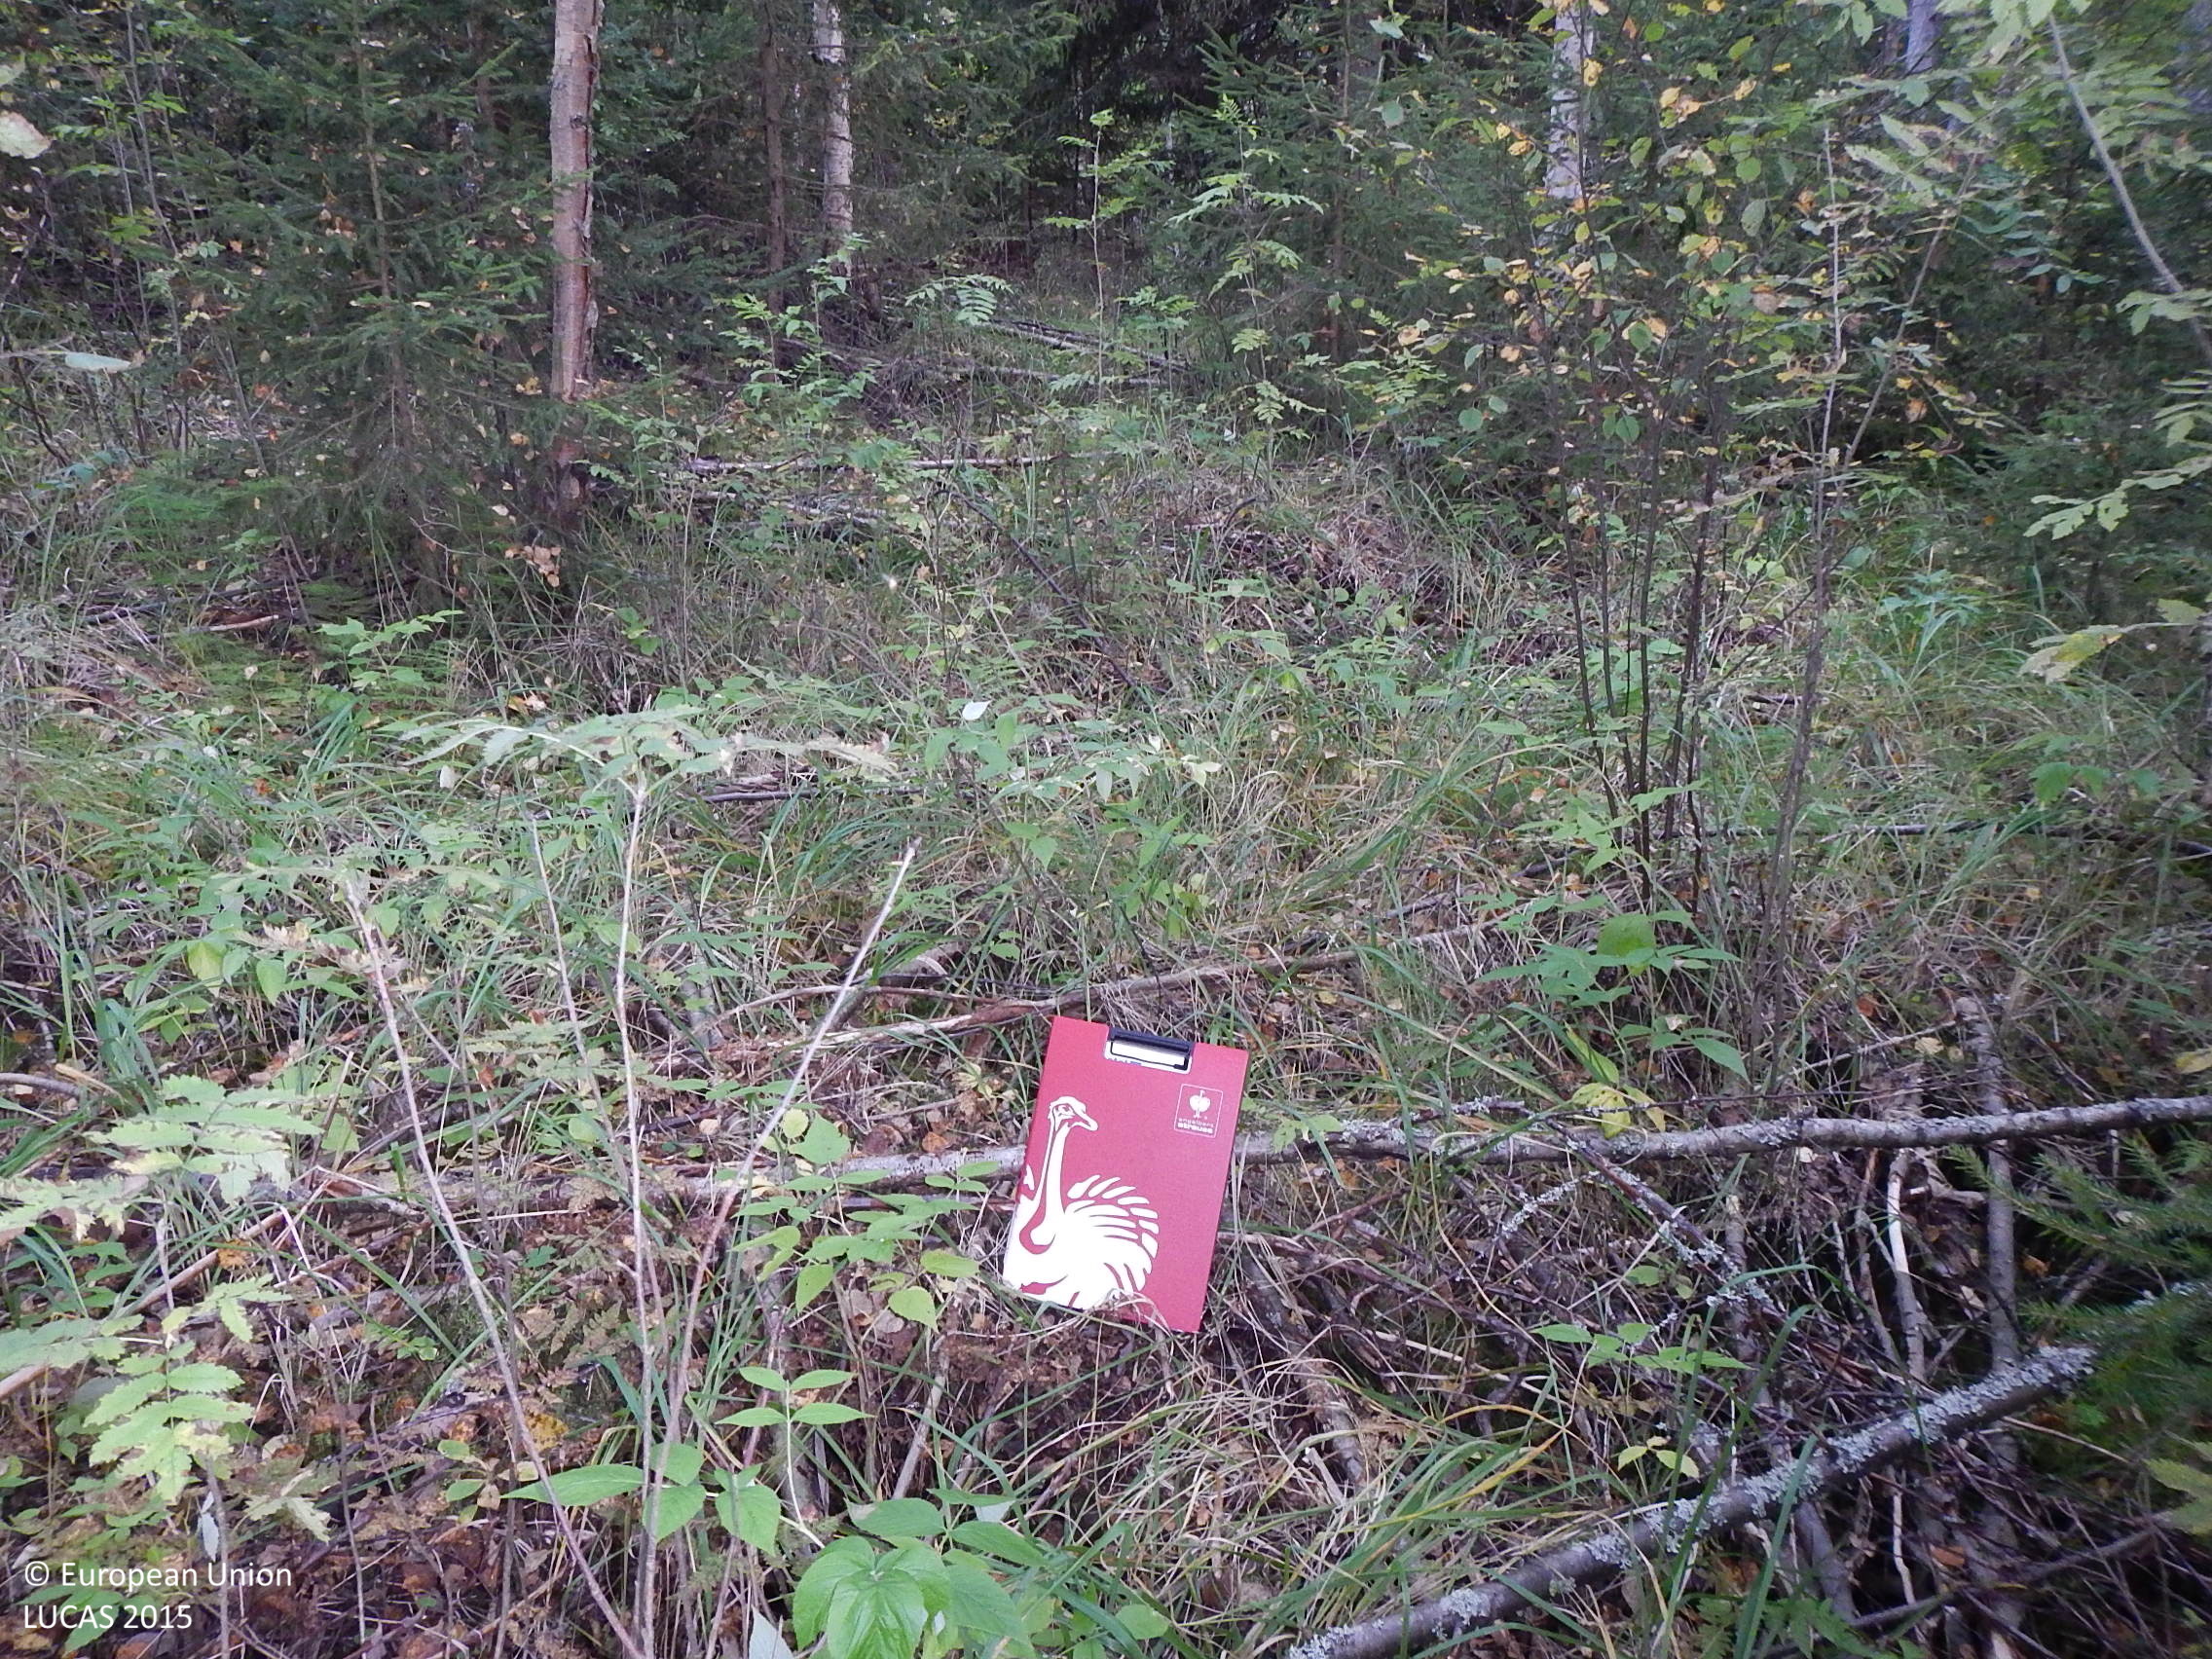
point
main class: Woodland
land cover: Spruce dominated mixed woodland
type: boreal forest
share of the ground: > 75 %
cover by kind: coniferous forest trees 40 %, broadleaved forest trees 40 %, herbaceous plants 15 %, shrubs 5 %
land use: Forestry
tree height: > 5 m
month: September
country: FI
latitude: 61.6097
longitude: 22.7545
